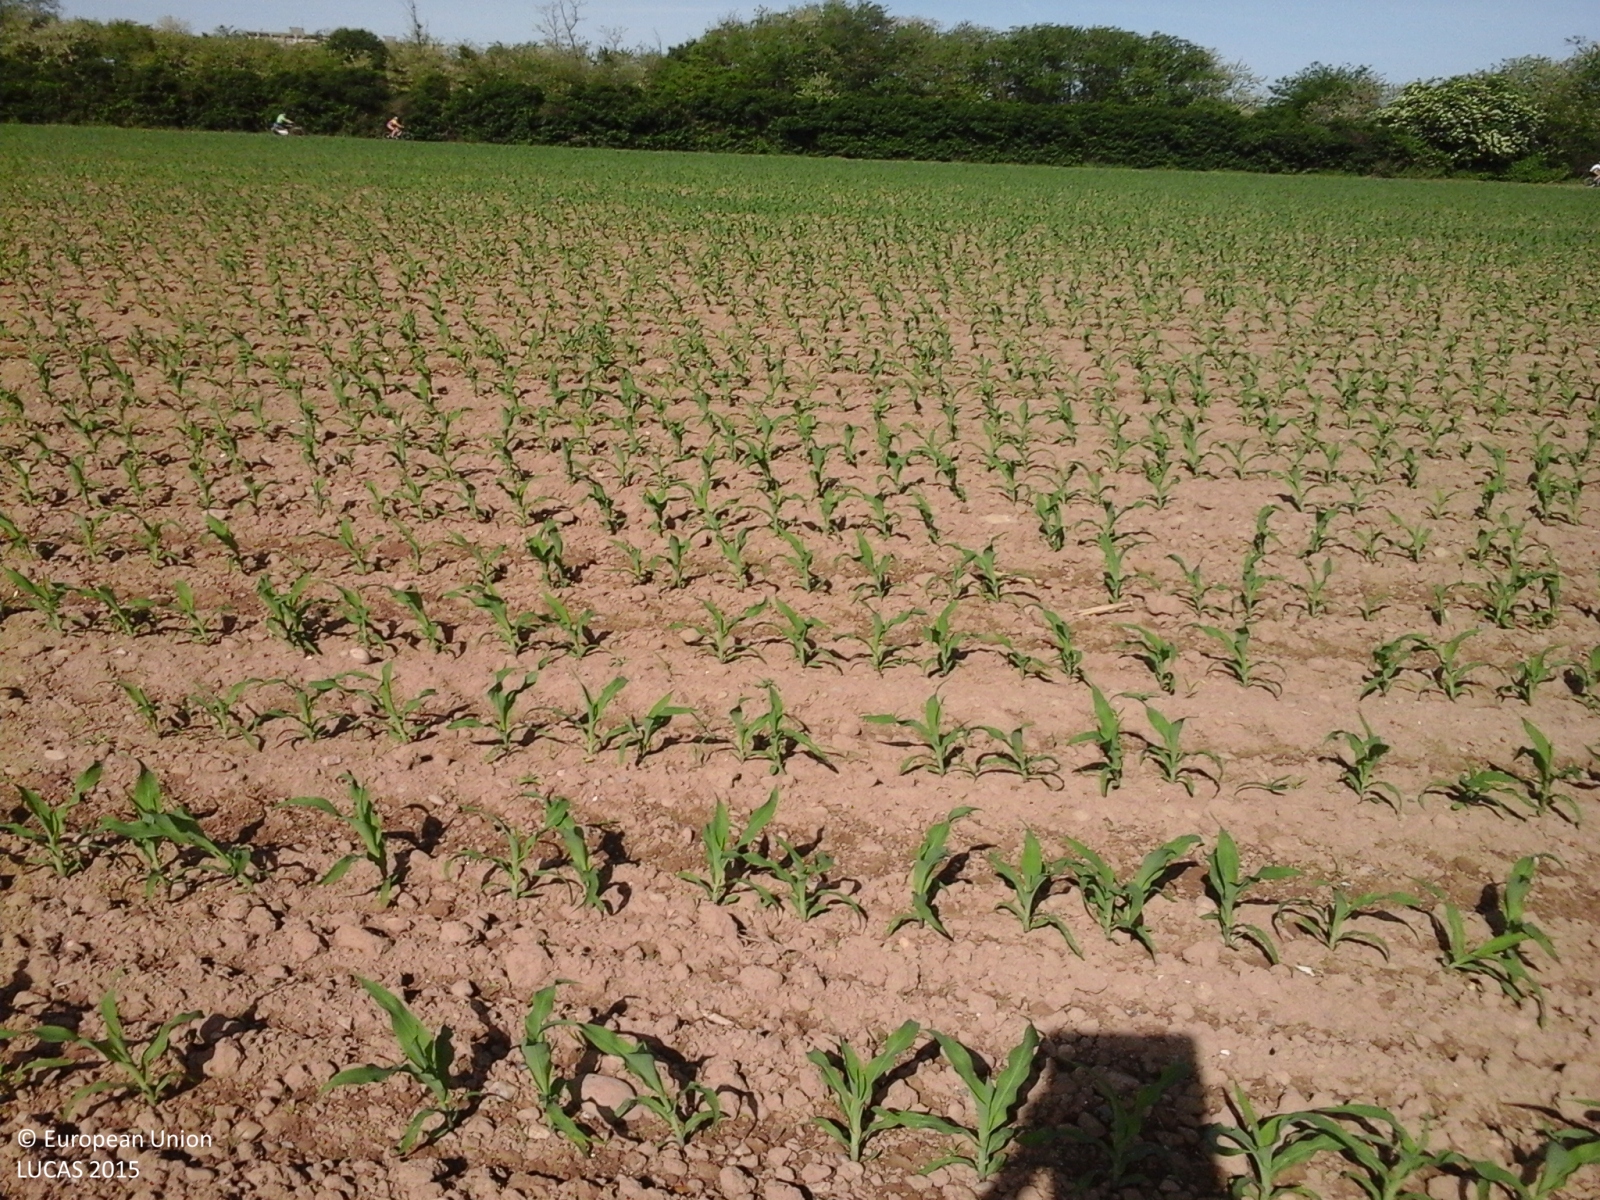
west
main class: Cropland
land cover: Maize
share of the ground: 10 - 25 %
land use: Agriculture (excluding fallow land and kitchen gardens)
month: May
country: IT
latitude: 45.5548
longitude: 9.1176
